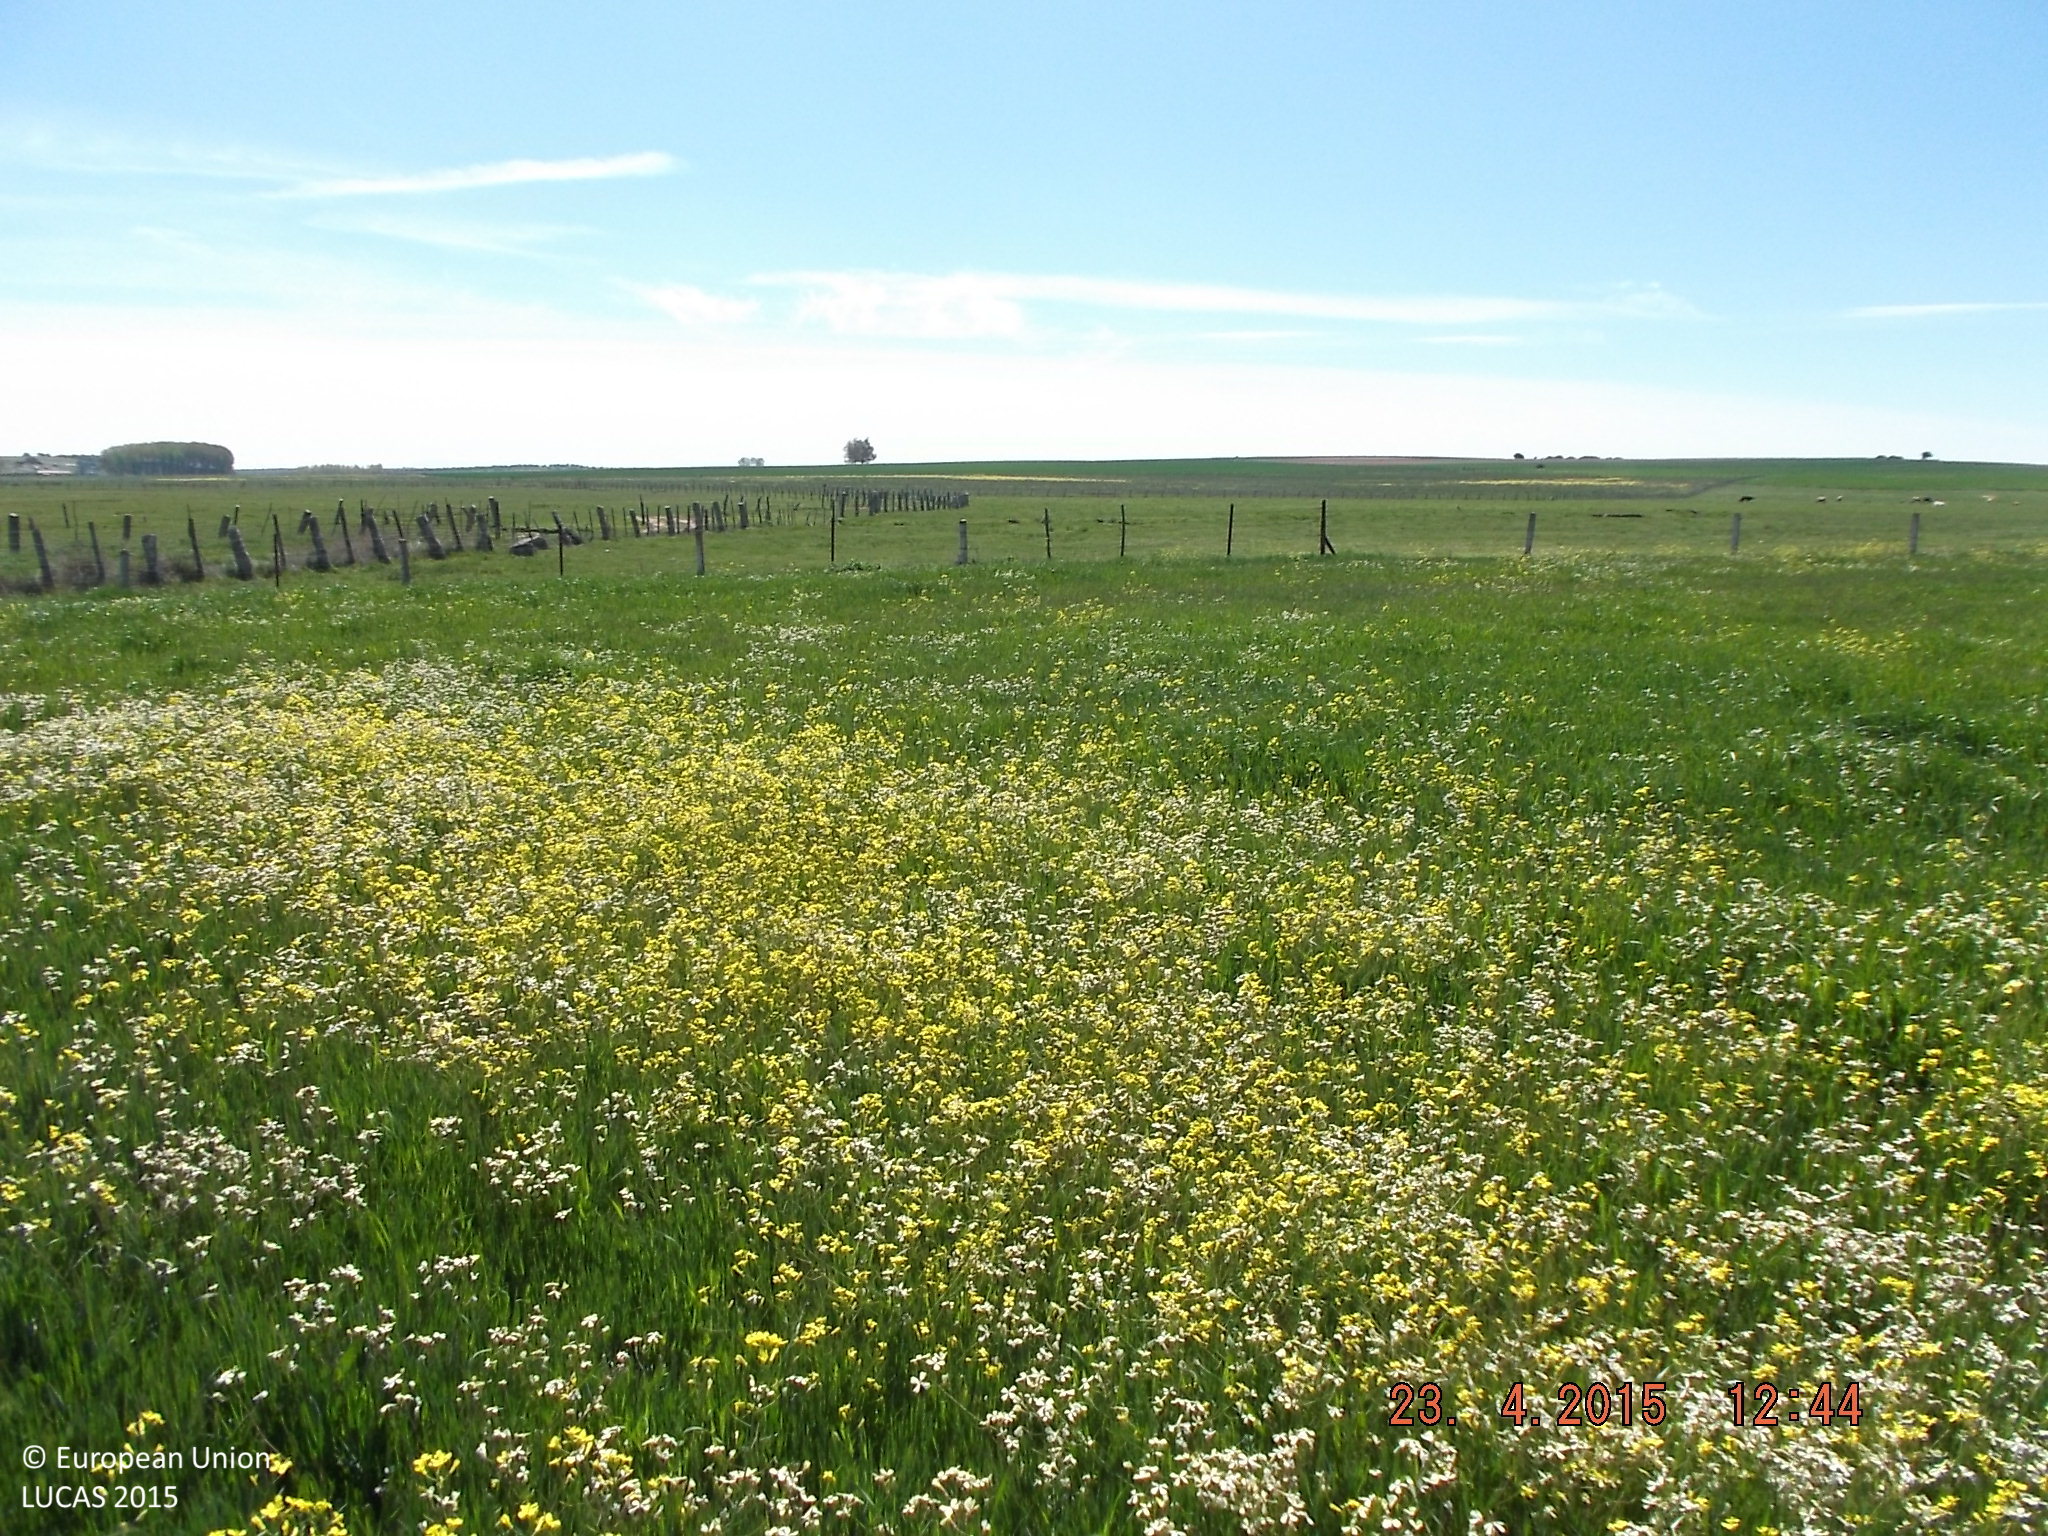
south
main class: Grassland
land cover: Grassland without tree/shrub cover
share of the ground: > 75 %
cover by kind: herbaceous plants 100 %
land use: Agriculture (excluding fallow land and kitchen gardens)
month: April
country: ES
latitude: 40.9841
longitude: -5.9020
